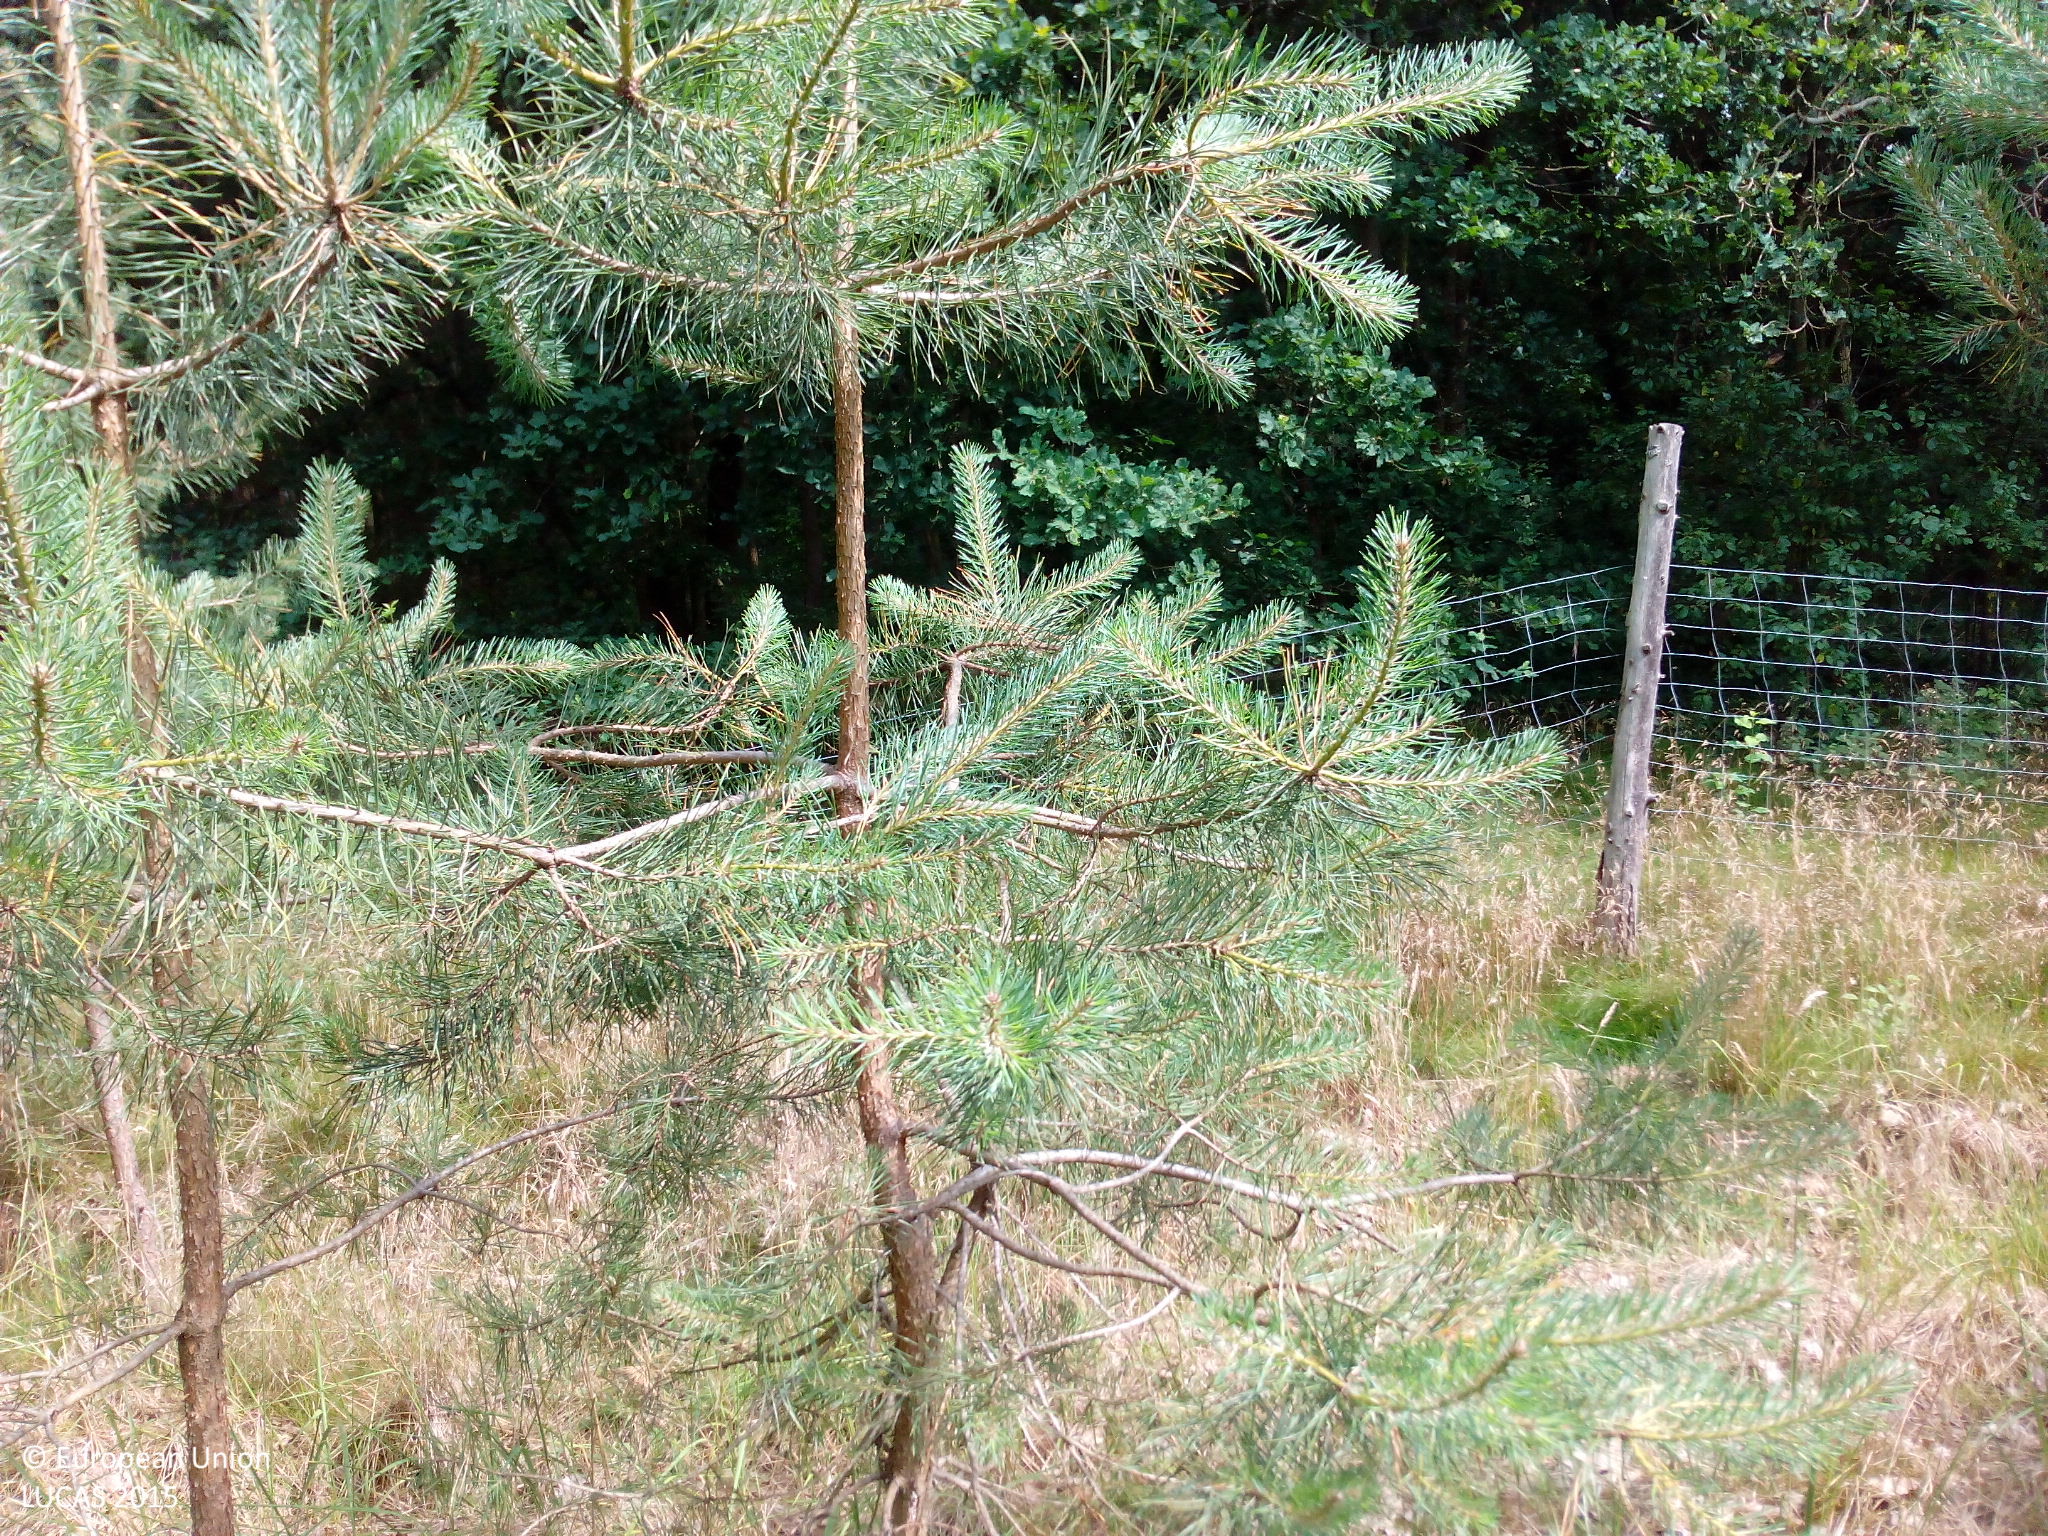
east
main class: Woodland
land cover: Pine dominated coniferous woodland
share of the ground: 50 - 75 %
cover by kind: coniferous forest trees 50 %, herbaceous plants 50 %
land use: Forestry
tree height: < 5 m
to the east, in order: Pine dominated coniferous woodland; Fences; Pine dominated mixed woodland; Inland marshes; Pine dominated mixed woodland; Ditches and canals; Common wheat
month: July
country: DE
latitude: 52.8760
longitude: 12.3322
